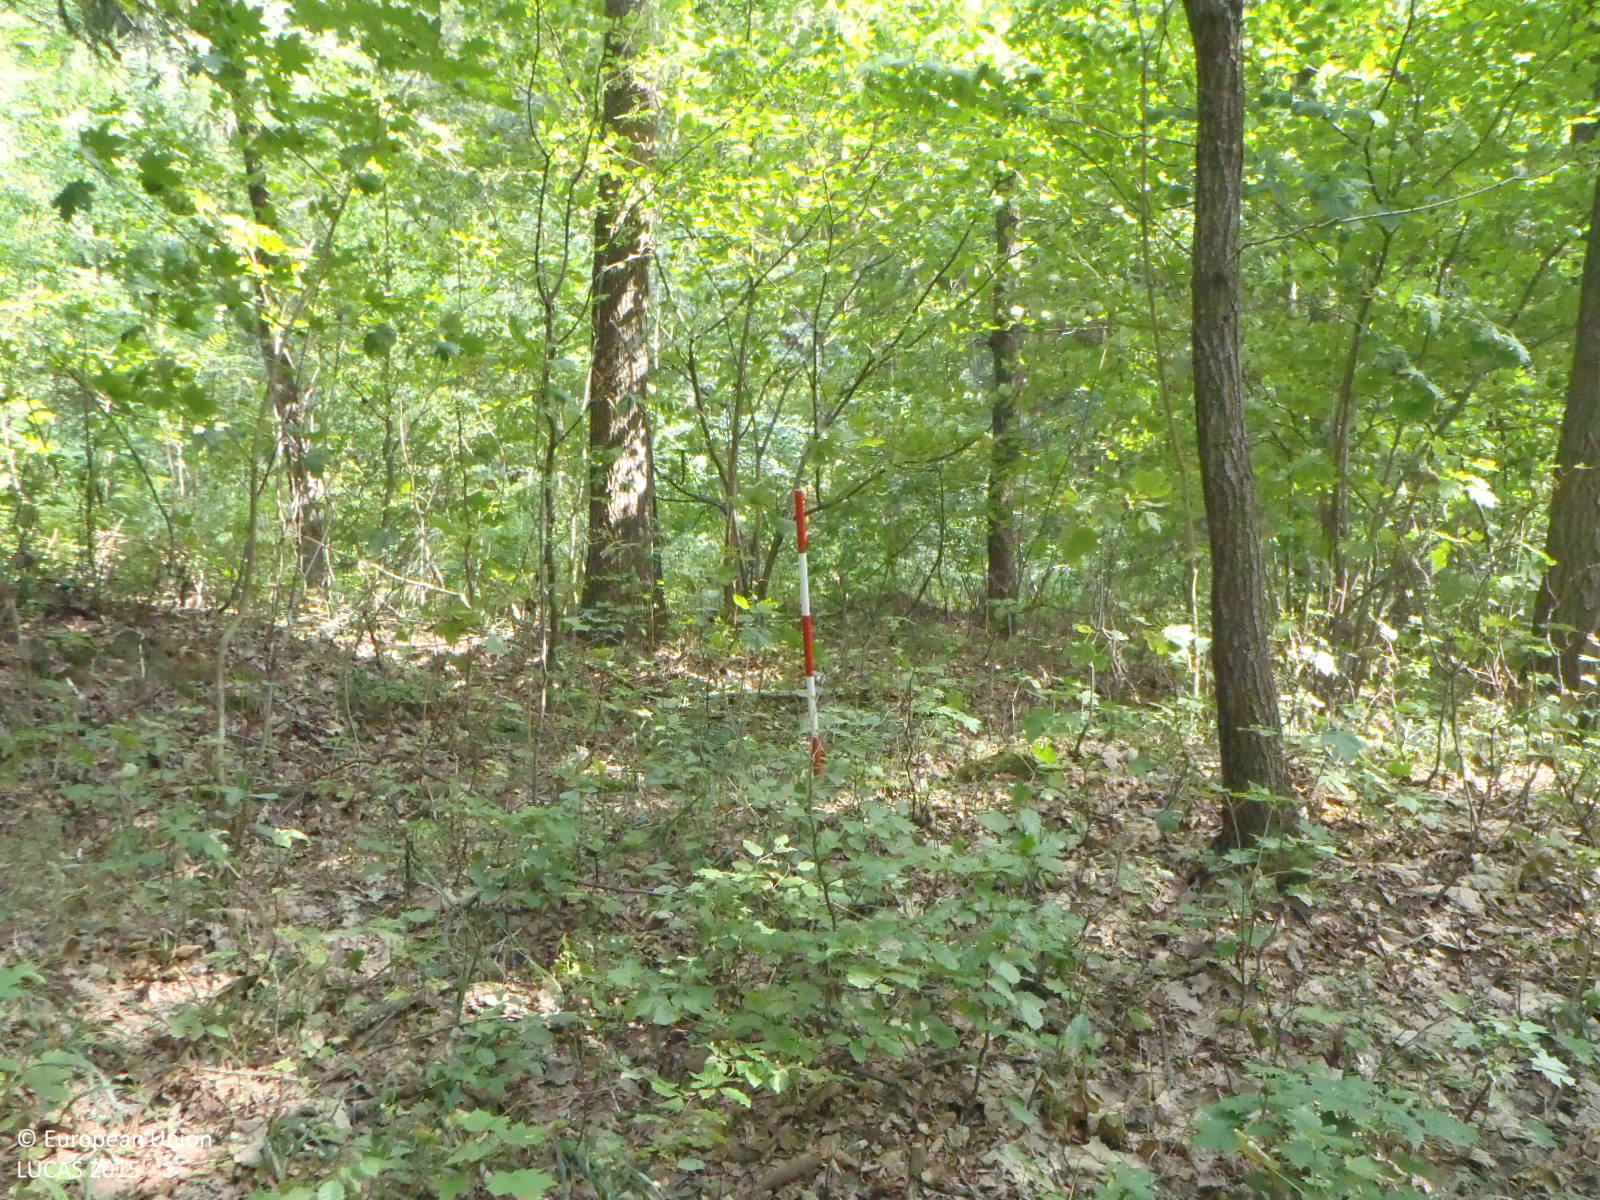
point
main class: Woodland
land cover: Spruce dominated mixed woodland
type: hemiboreal forest and nemoral coniferous forest and mixed broadleaved-coniferous forest
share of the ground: > 75 %
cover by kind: broadleaved forest trees 70 %, coniferous forest trees 30 %
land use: Forestry
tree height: > 5 m
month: September
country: CZ
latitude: 50.6938
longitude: 13.8939
